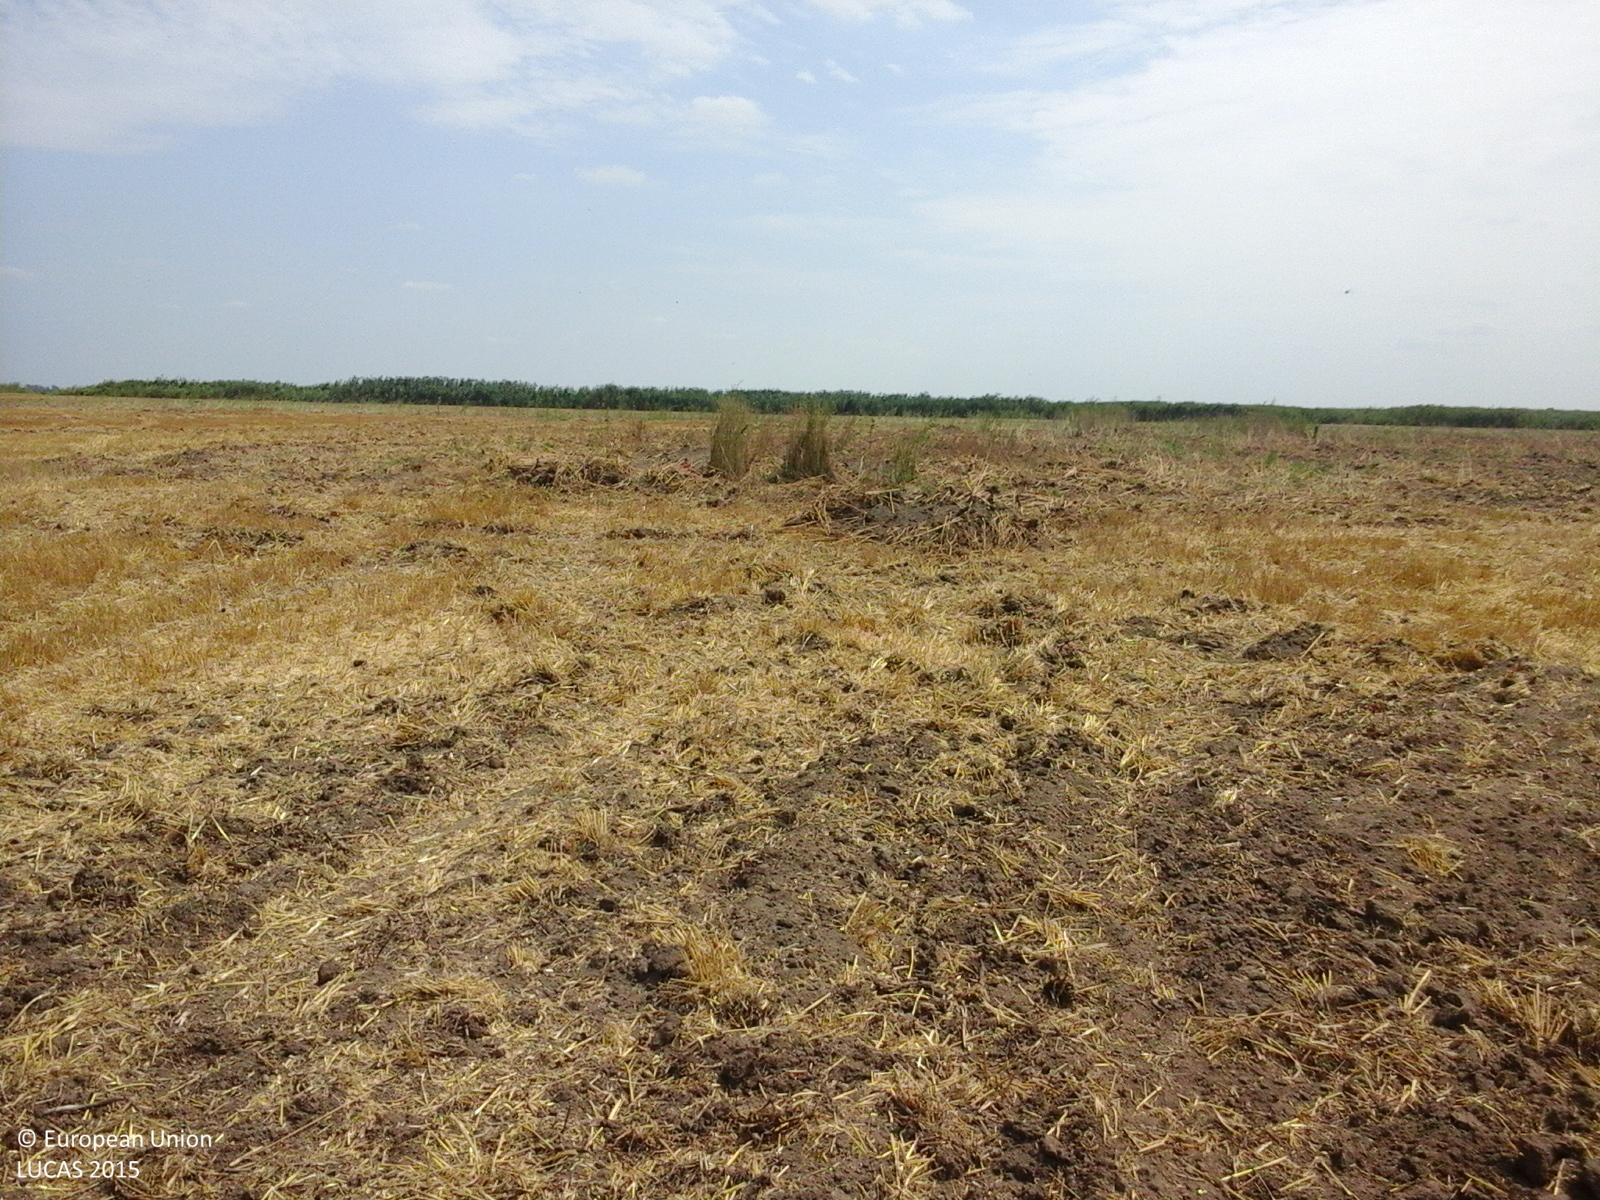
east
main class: Cropland
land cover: Barley
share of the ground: 10 - 25 %
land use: Agriculture (excluding fallow land and kitchen gardens)
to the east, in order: Barley
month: August
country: RO
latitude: 45.2871
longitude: 29.0324
